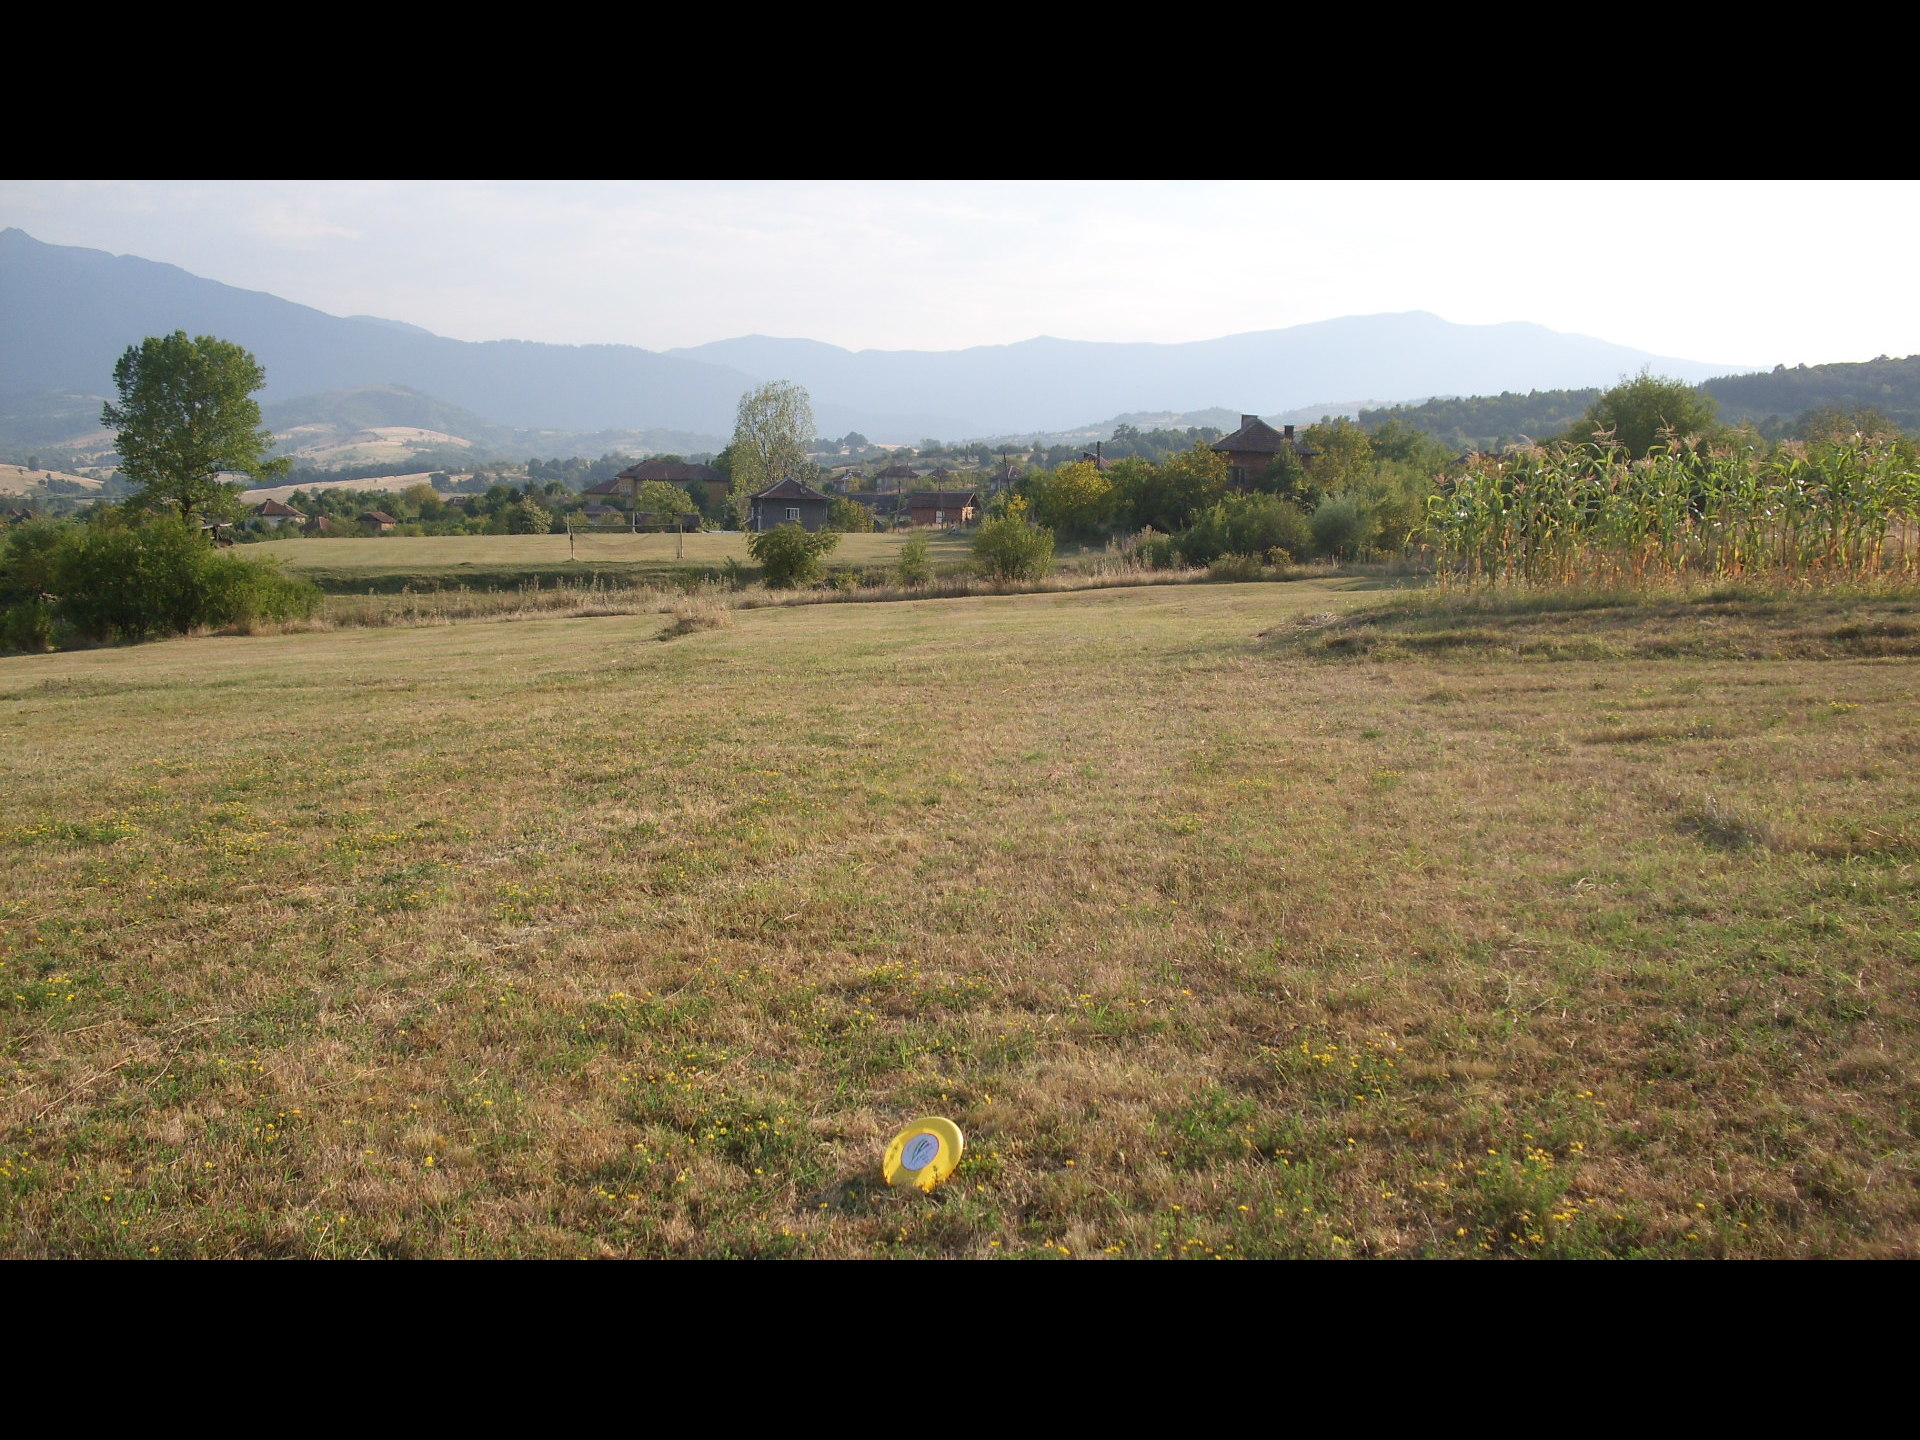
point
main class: Grassland
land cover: Grassland without tree/shrub cover
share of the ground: > 75 %
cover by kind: herbaceous plants 100 %
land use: Agriculture (excluding fallow land and kitchen gardens)
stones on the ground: < 10 %
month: August
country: BG
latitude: 43.2406
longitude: 23.2524
